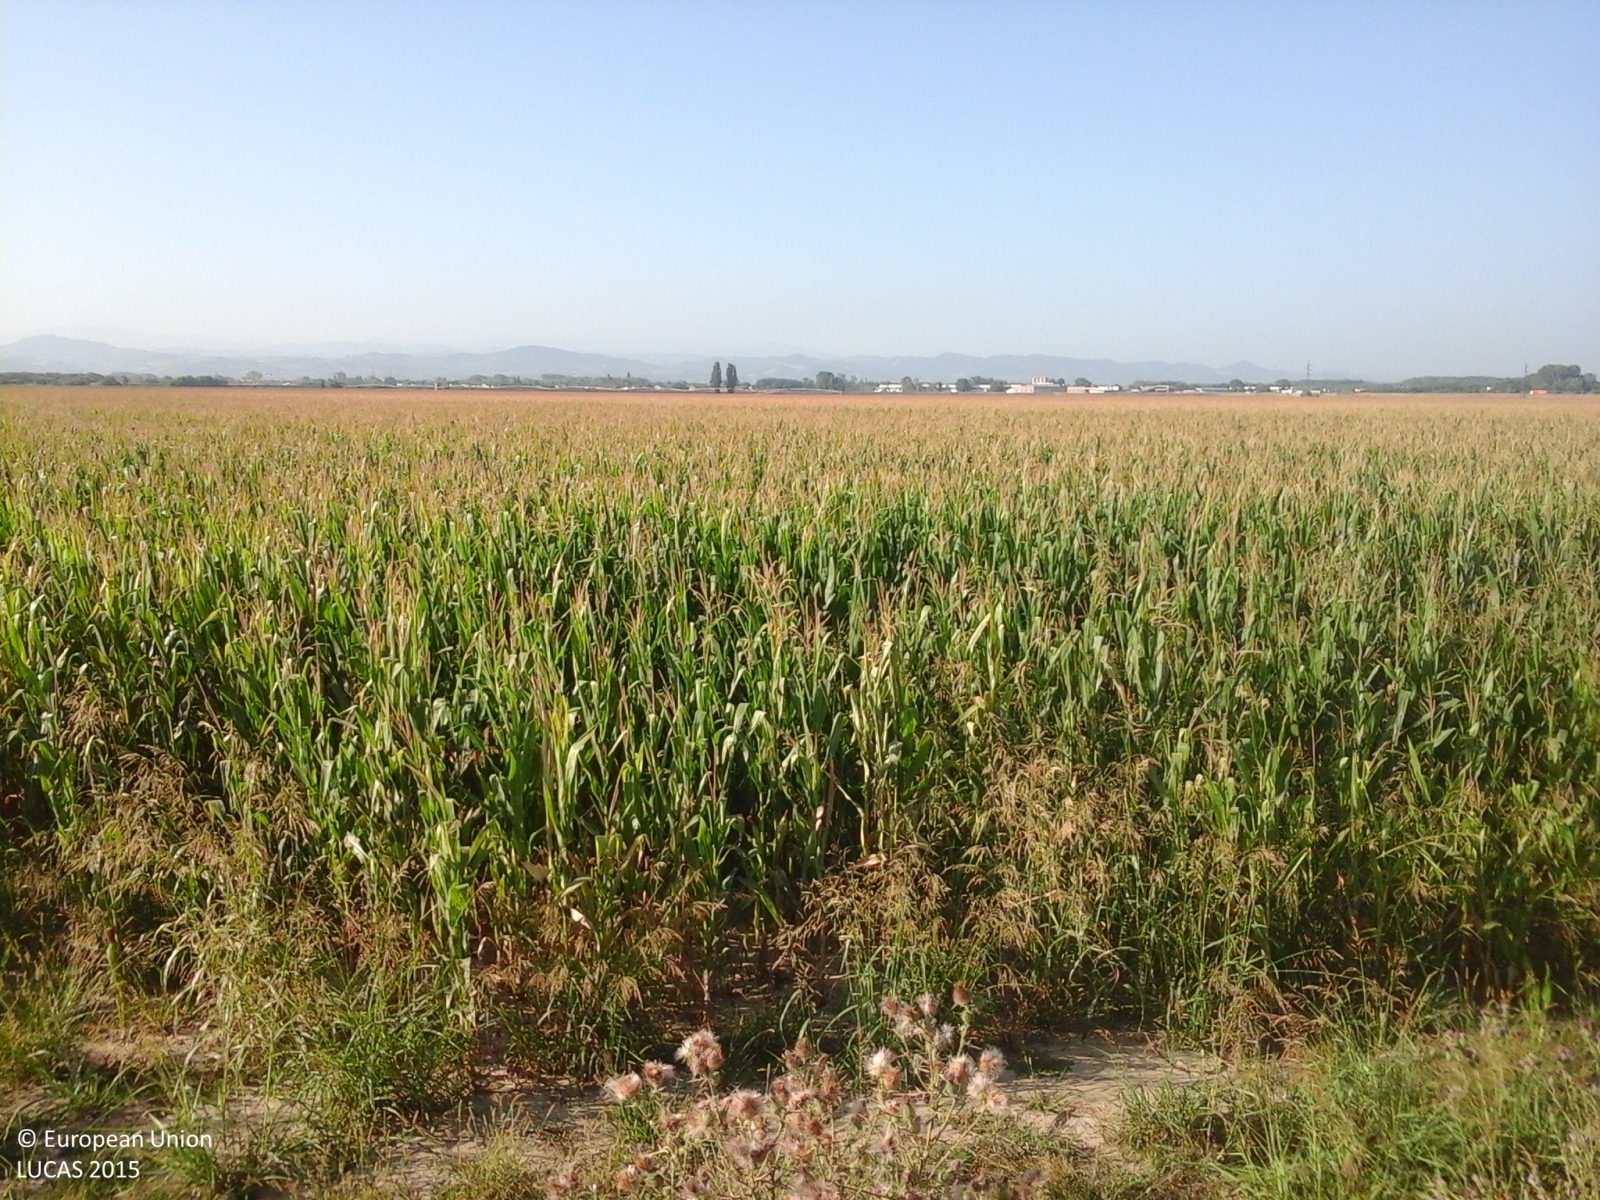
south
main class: Cropland
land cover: Maize
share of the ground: > 75 %
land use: Agriculture (excluding fallow land and kitchen gardens)
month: July
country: IT
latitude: 45.1042
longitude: 9.1247
